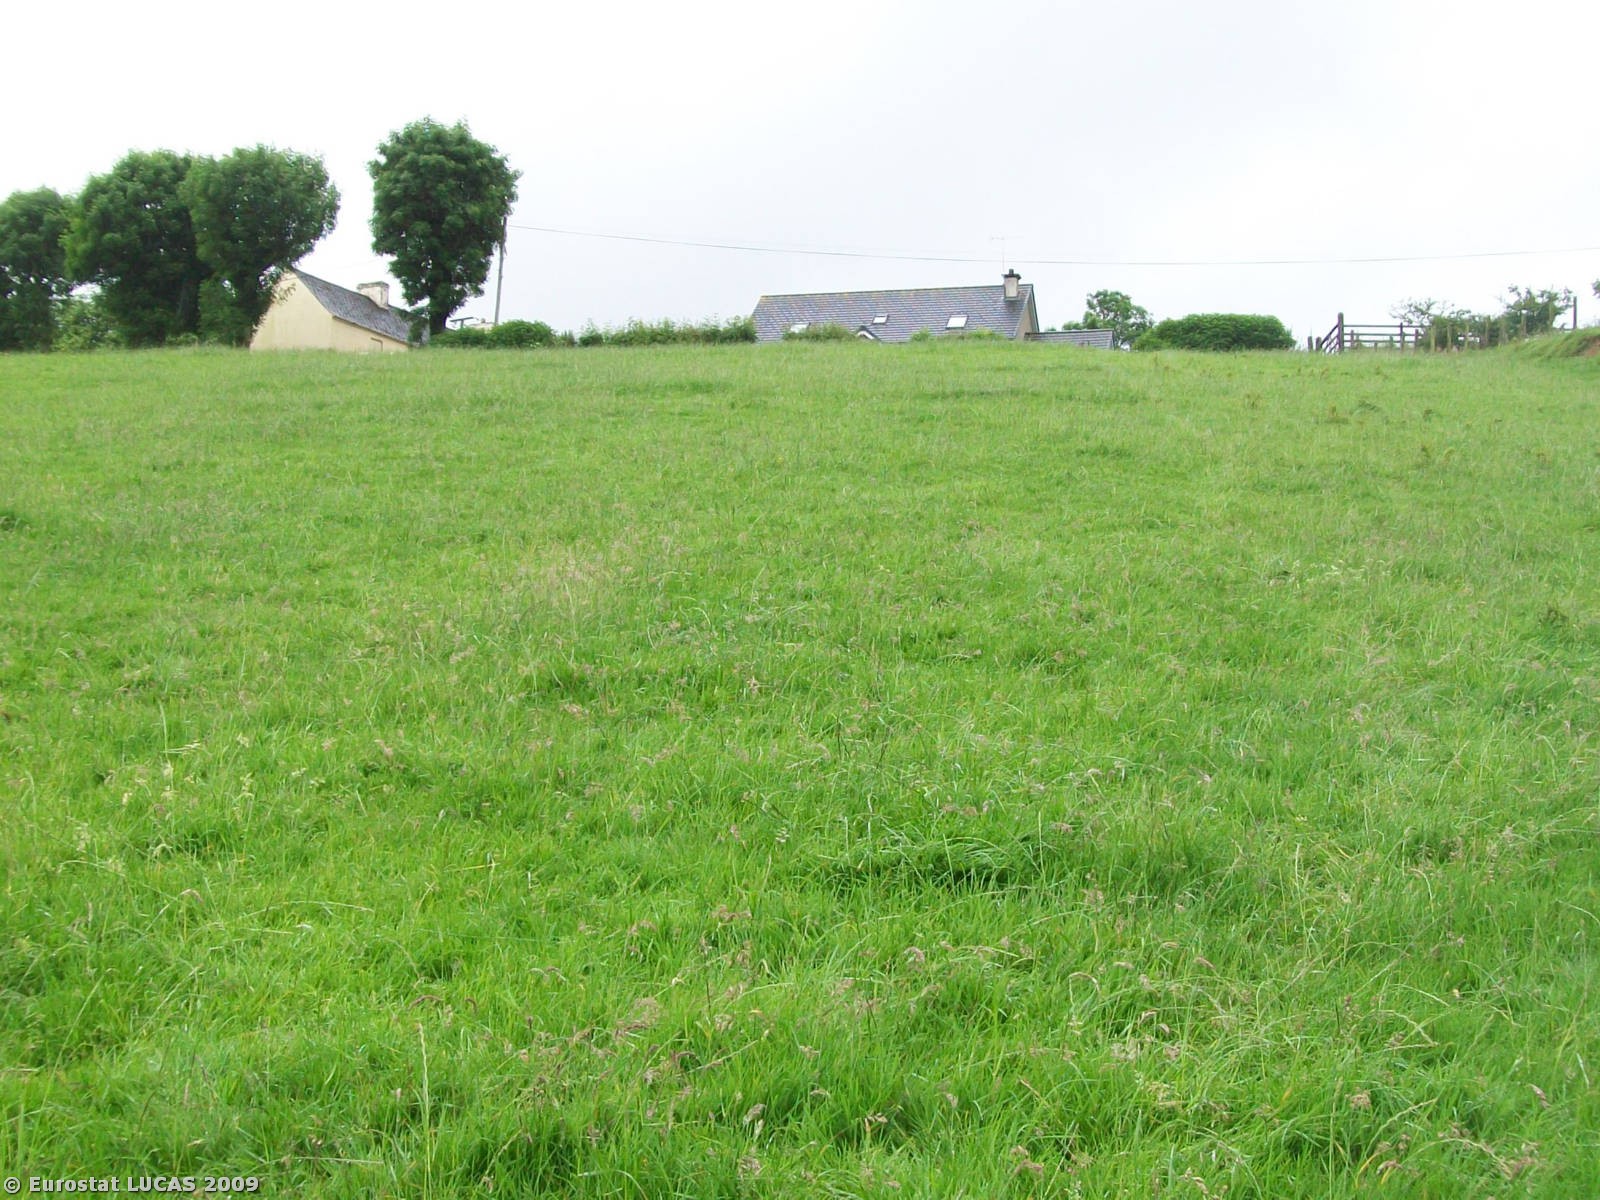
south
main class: Grassland
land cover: Grassland without tree/shrub cover
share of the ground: > 75 %
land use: Agriculture (excluding fallow land and kitchen gardens)
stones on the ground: < 10 %
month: July
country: GB
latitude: 54.7601
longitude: -7.1605
